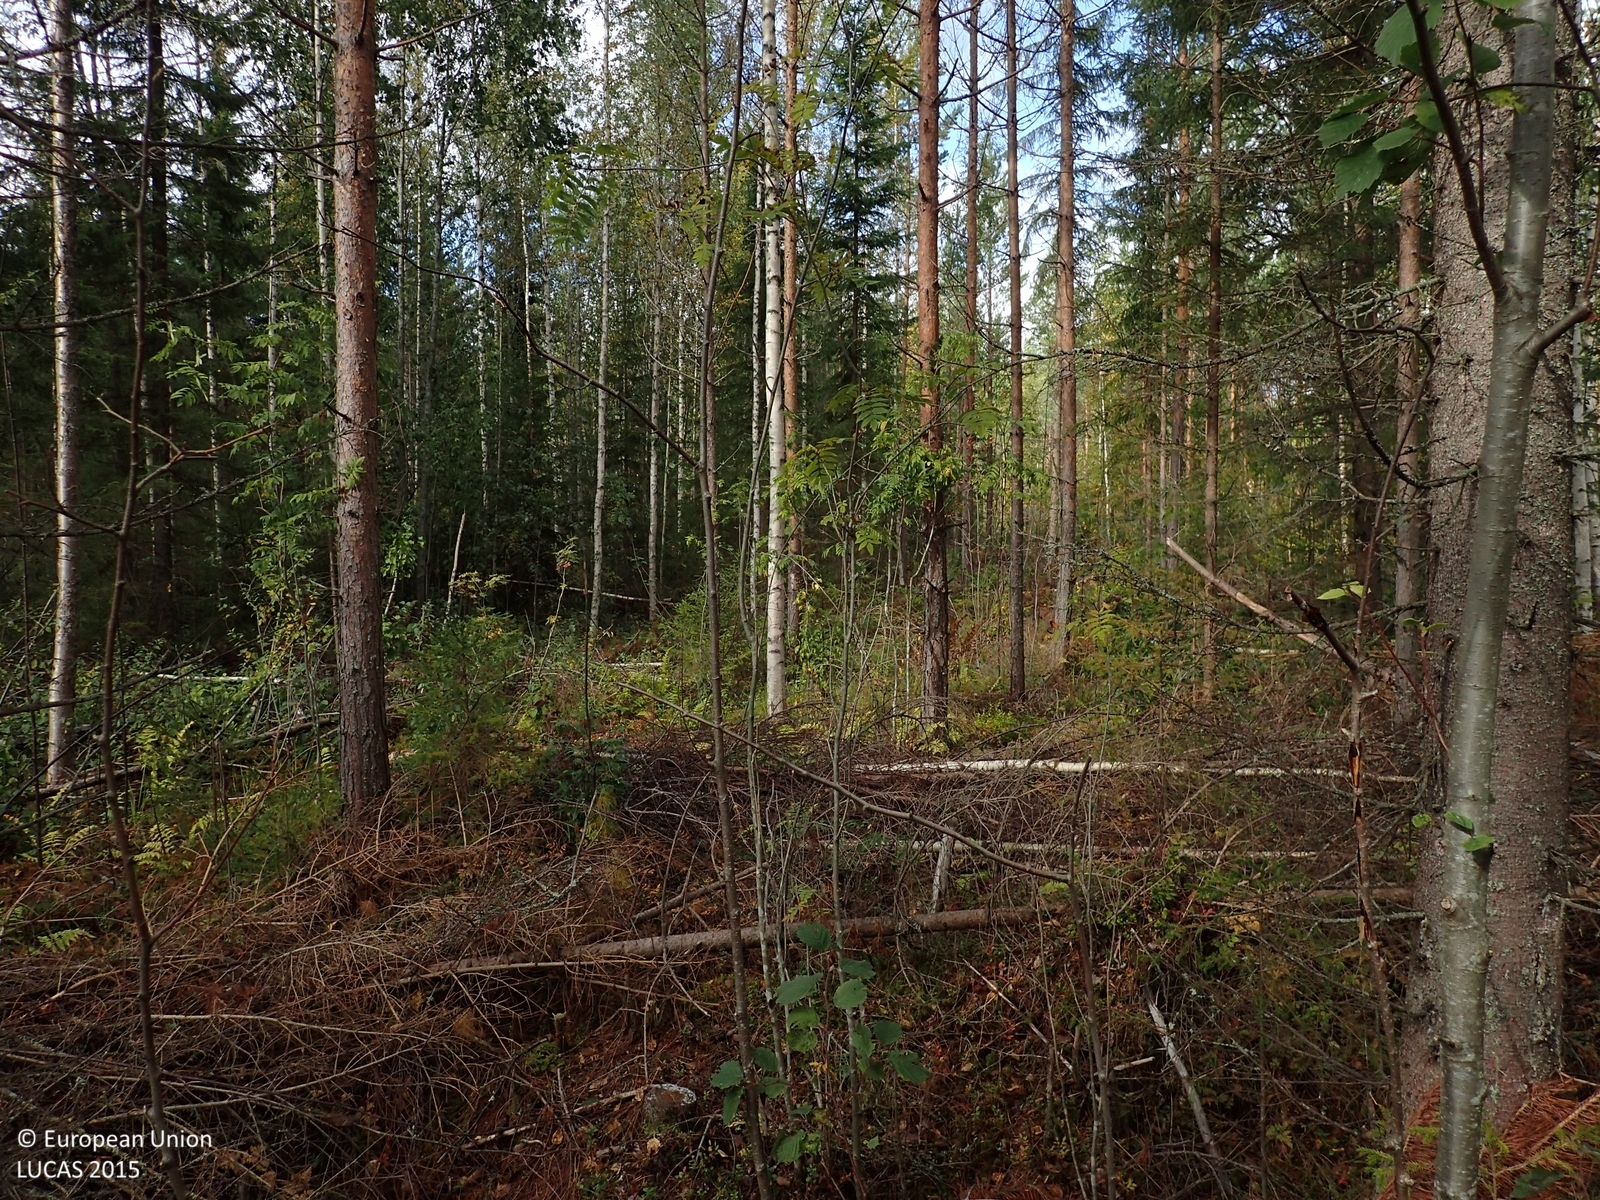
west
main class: Woodland
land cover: Spruce dominated mixed woodland
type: boreal forest
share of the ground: > 75 %
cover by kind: coniferous forest trees 55 %, broadleaved forest trees 20 %, shrubs 15 %, herbaceous plants 5 %, lichens and mosses 5 %
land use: Forestry
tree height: > 5 m
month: September
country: FI
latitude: 63.1296
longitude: 25.1495
